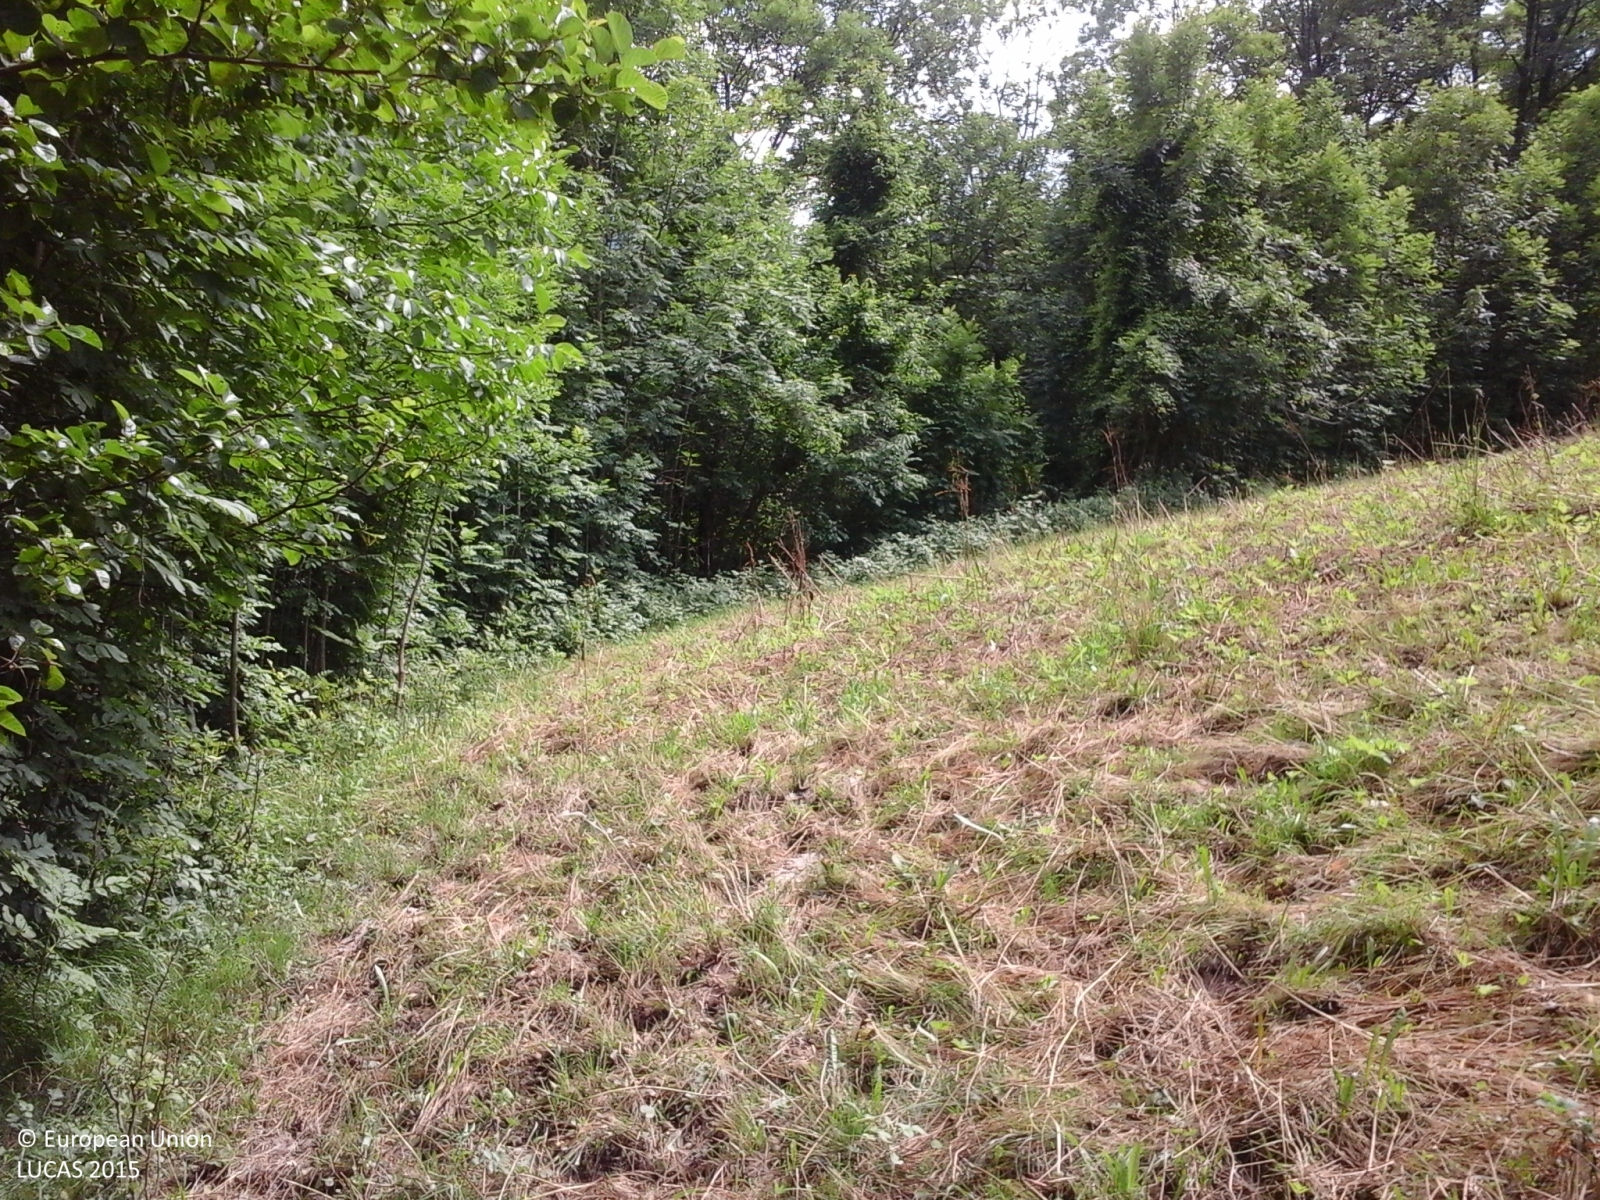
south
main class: Grassland
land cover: Grassland without tree/shrub cover
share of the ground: > 75 %
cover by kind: herbaceous plants 100 %
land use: Agriculture (excluding fallow land and kitchen gardens)
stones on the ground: < 10 %
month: June
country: IT
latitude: 44.2379
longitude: 7.8387
